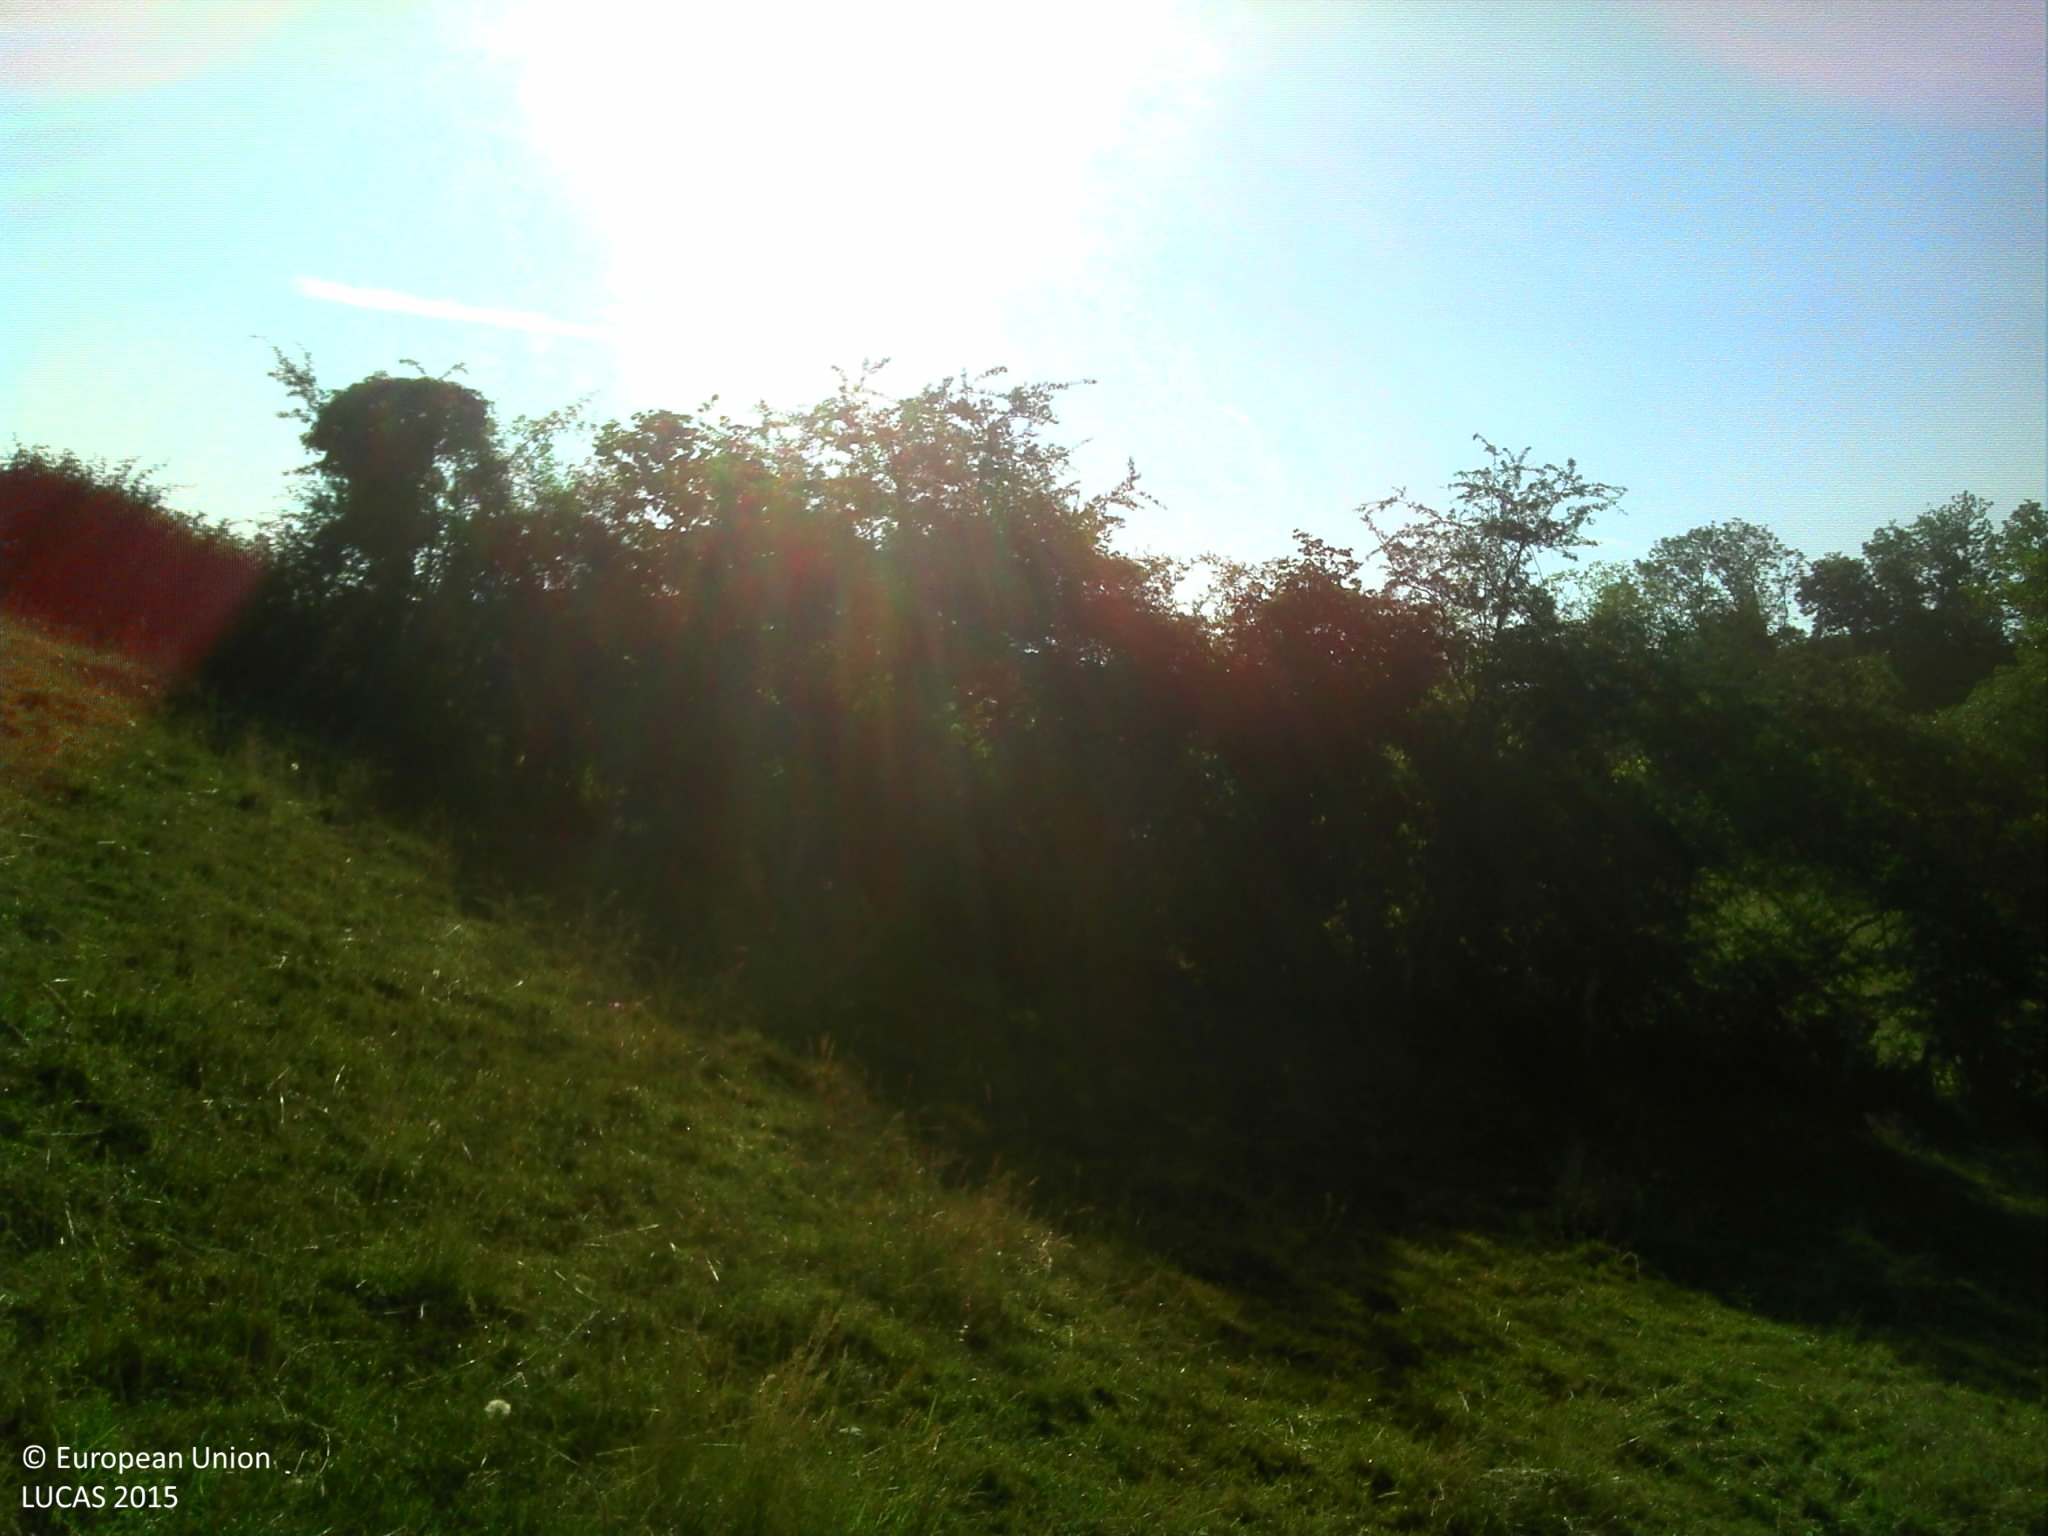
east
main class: Grassland
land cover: Grassland without tree/shrub cover
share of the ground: > 75 %
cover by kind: herbaceous plants 100 %
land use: Agriculture (excluding fallow land and kitchen gardens)
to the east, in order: Grassland without tree/shrub cover; Managed hedges; Fences; Grassland without tree/shrub cover; Managed hedges; Grassland without tree/shrub cover; Fences; Grassland without tree/shrub cover
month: June
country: FR
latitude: 46.4967
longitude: 4.4637
